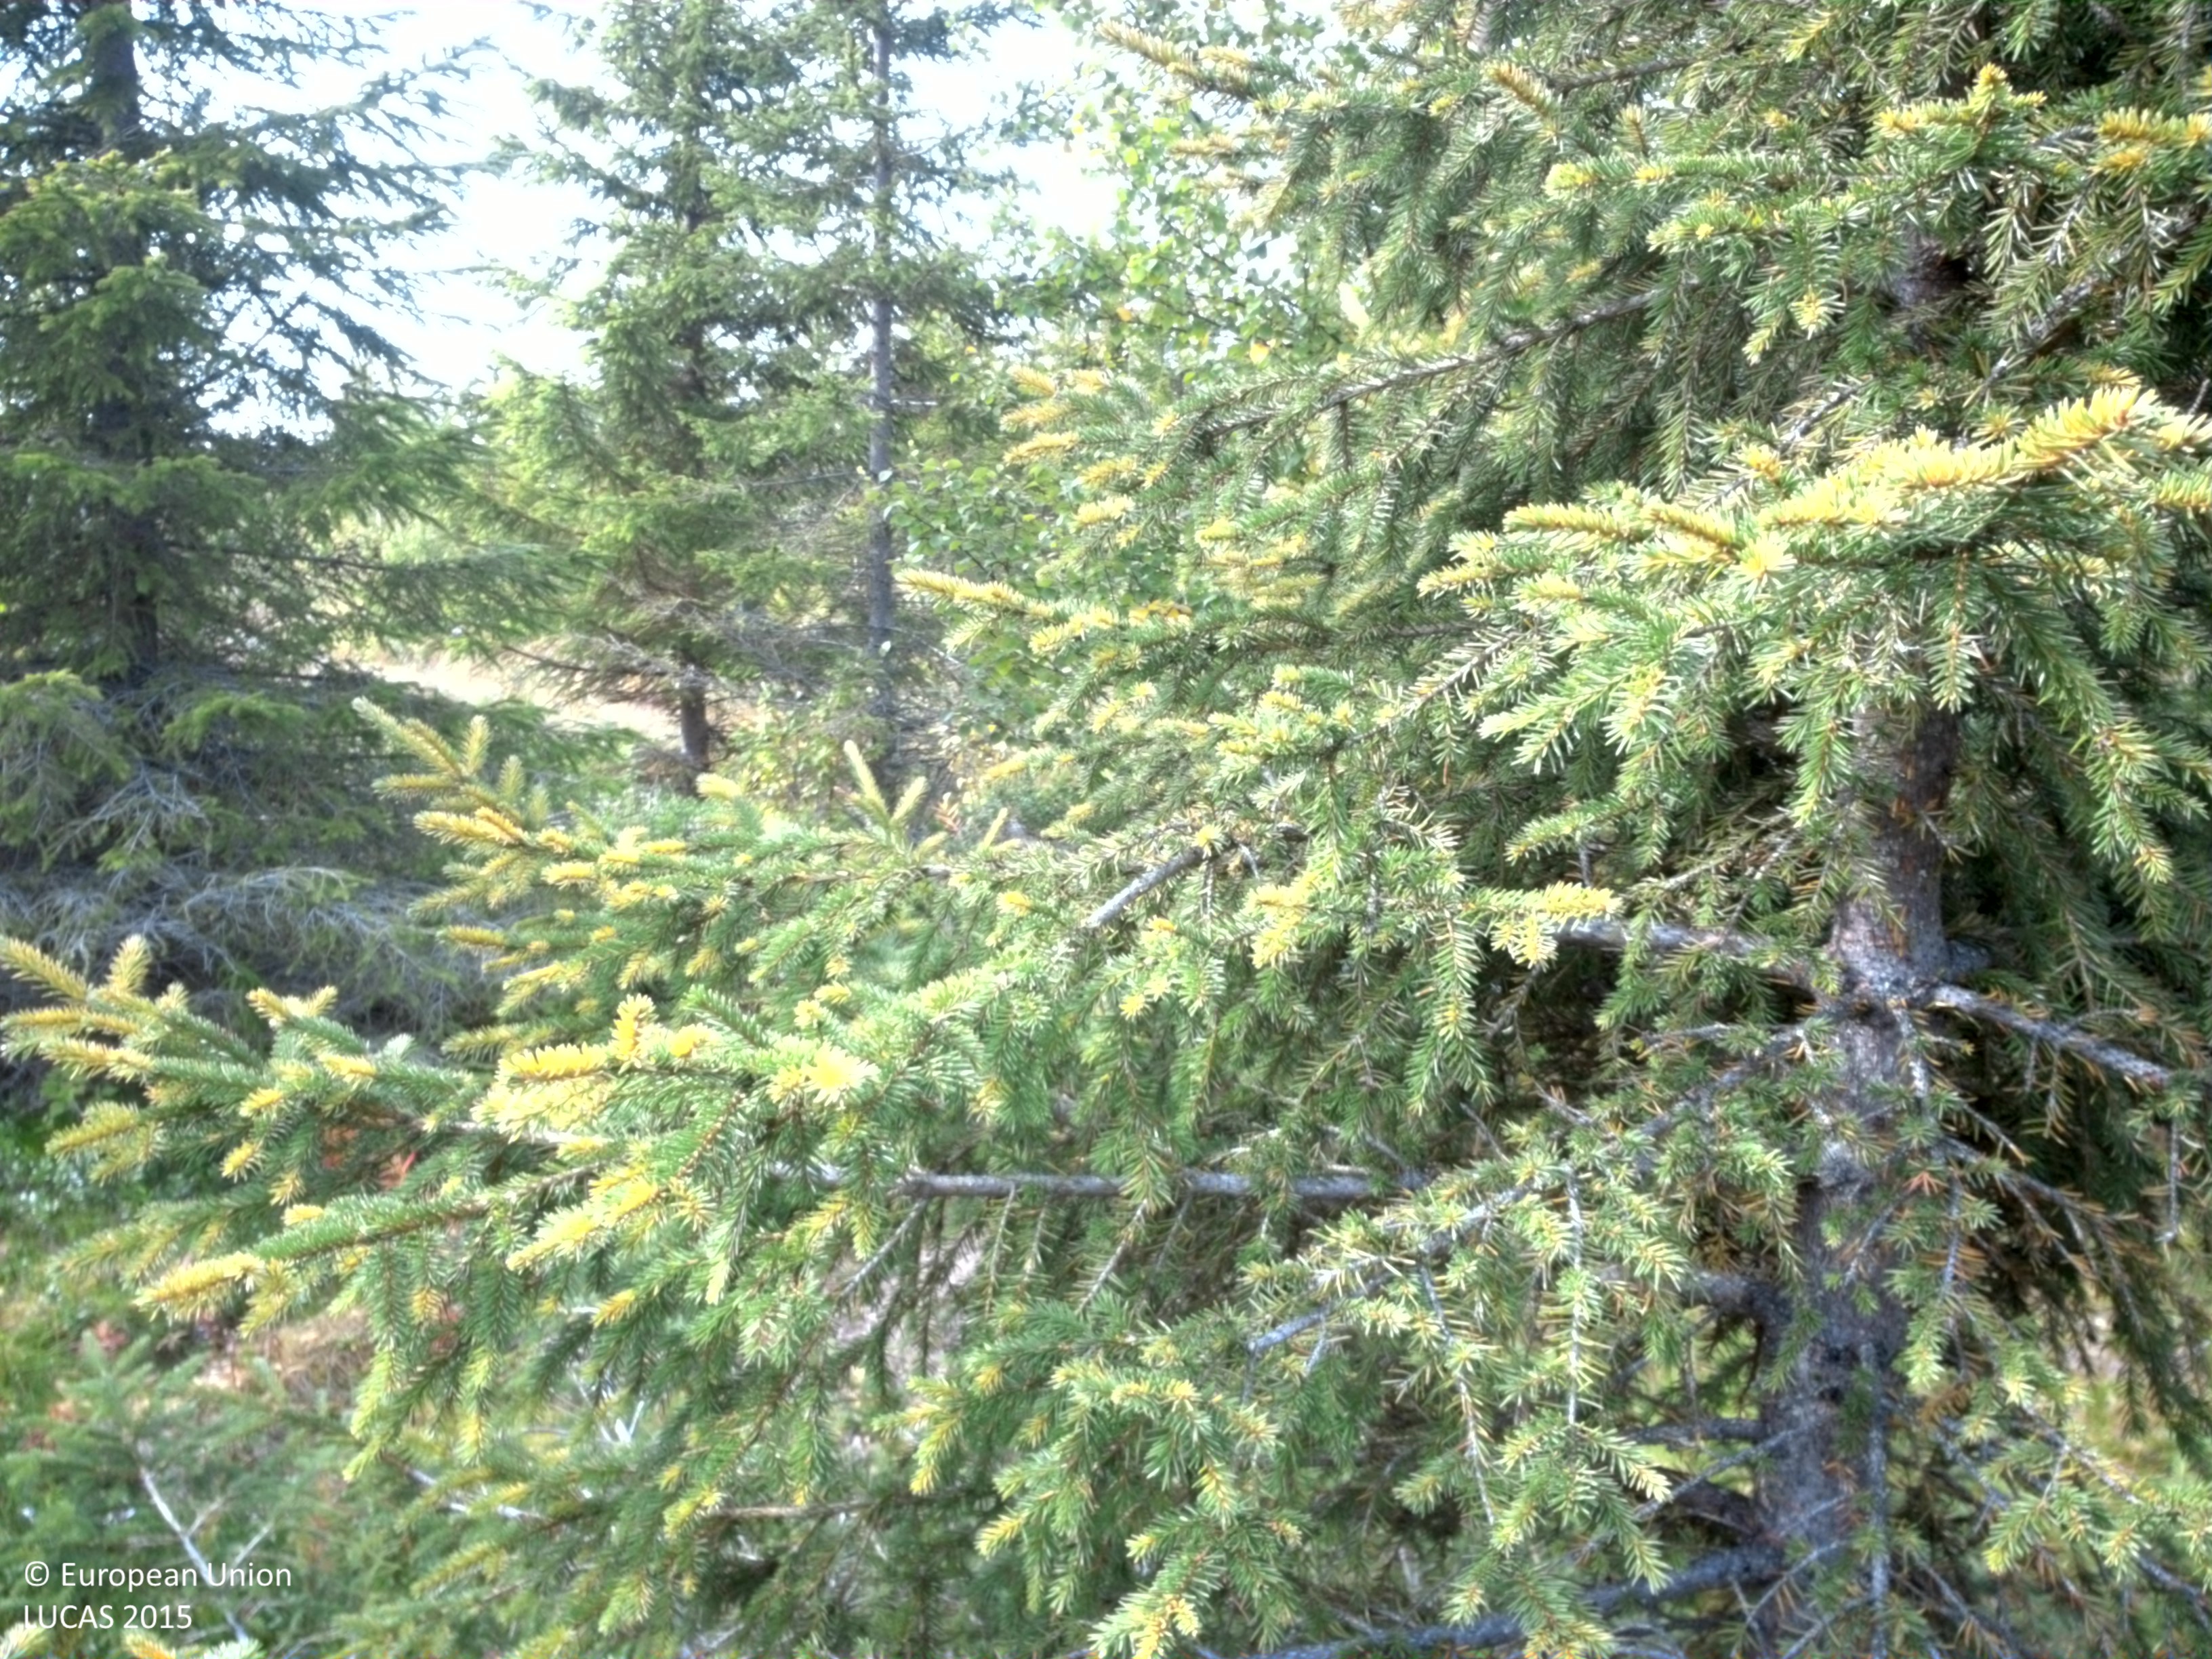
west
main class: Woodland
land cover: Spruce dominated mixed woodland
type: boreal forest
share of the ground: 10 - 25 %
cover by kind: herbaceous plants 35 %, shrubs 25 %, lichens and mosses 20 %, coniferous forest trees 15 %, broadleaved forest trees 5 %
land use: Forestry
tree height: > 5 m
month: September
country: SE
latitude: 65.4011
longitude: 16.6575
